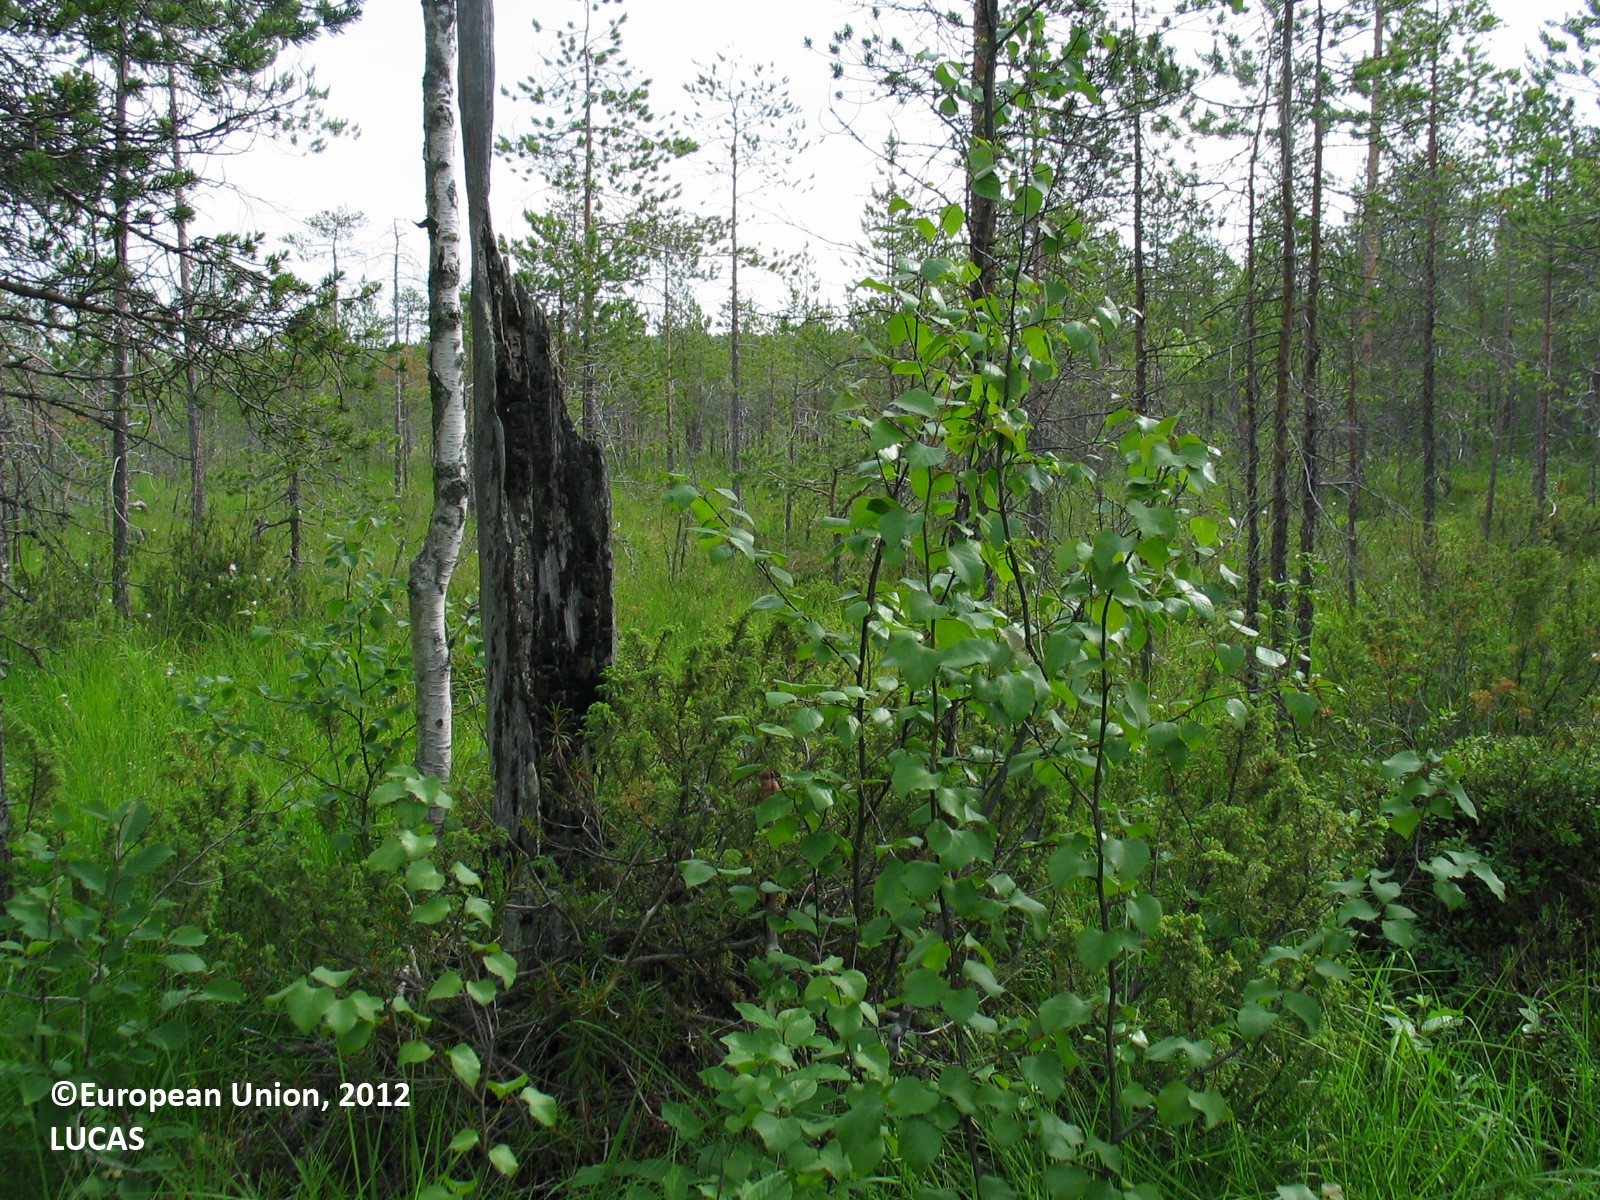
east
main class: Woodland
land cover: Pine dominated coniferous woodland
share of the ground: 25 - 50 %
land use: Semi-natural and natural areas not in use
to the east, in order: Pine dominated coniferous woodland; Peatbogs; Other mixed woodland
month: July
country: FI
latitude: 65.9761
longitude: 25.1424
